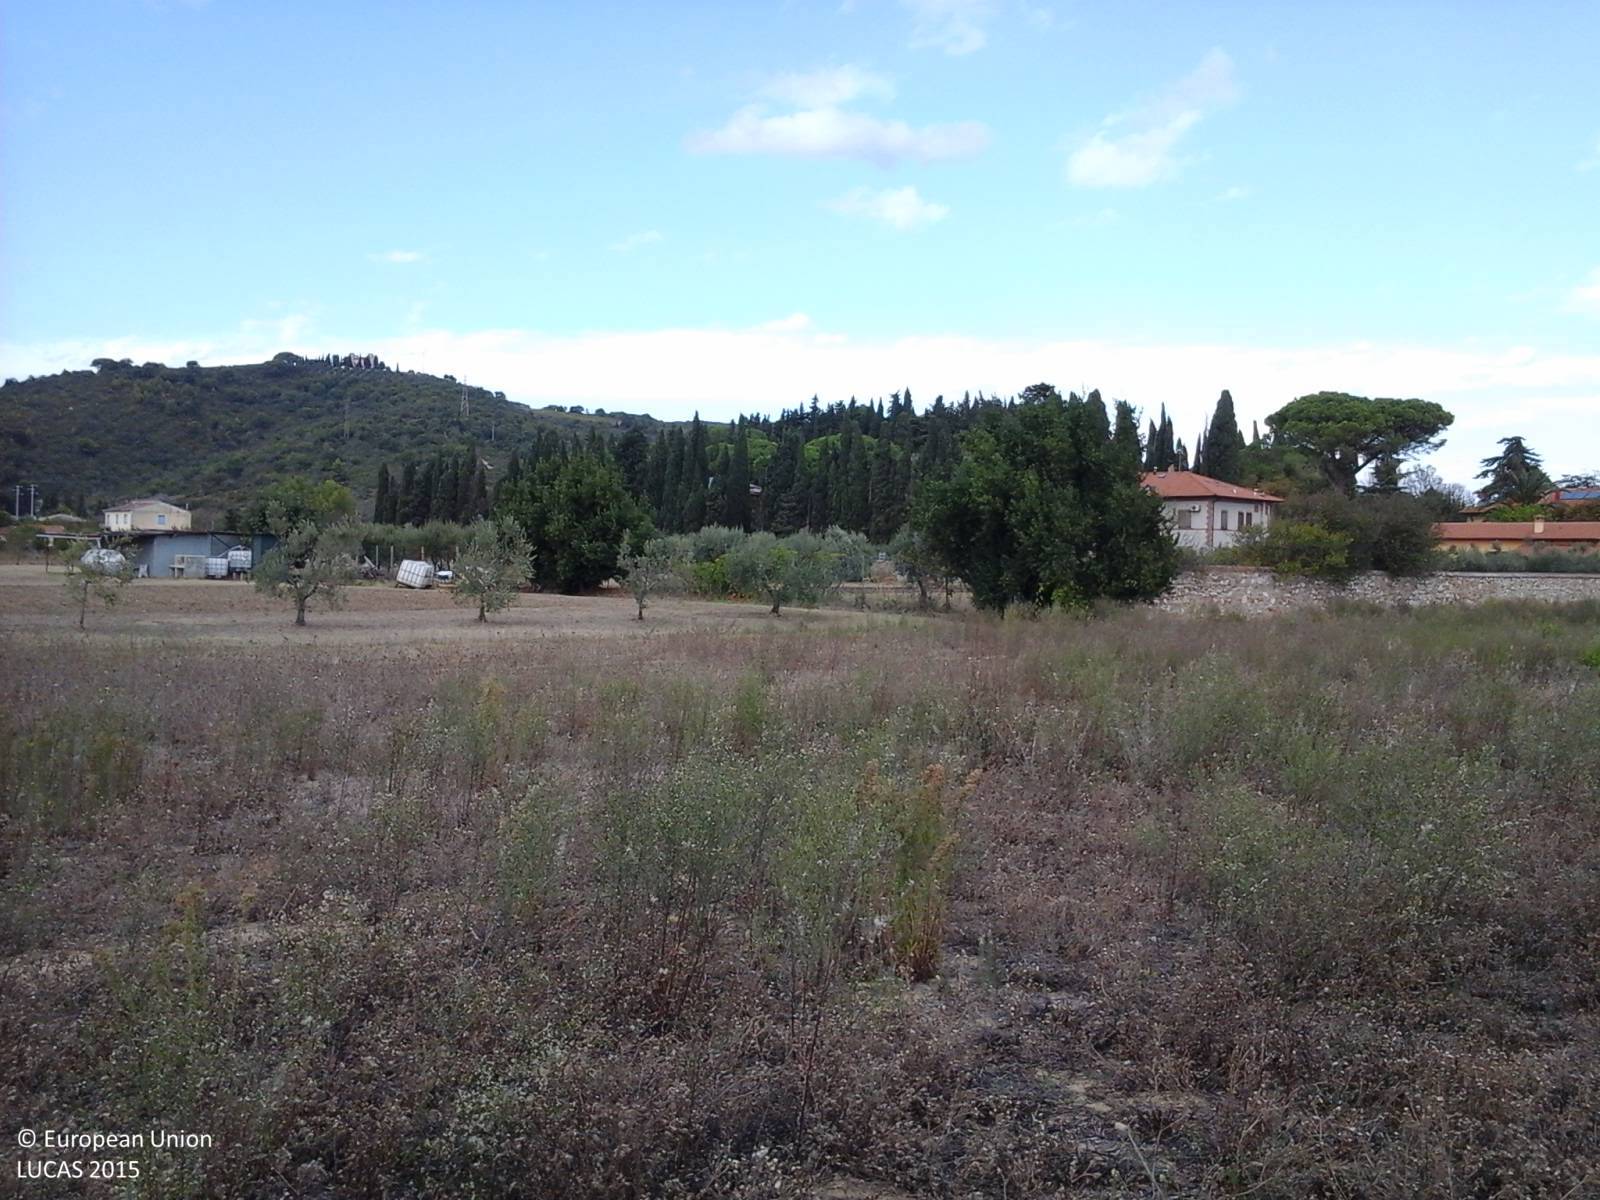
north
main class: Grassland
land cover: Spontaneously vegetated surfaces
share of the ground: > 75 %
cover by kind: herbaceous plants 100 %
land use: Fallow land
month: September
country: IT
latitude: 43.0313
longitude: 10.6240
